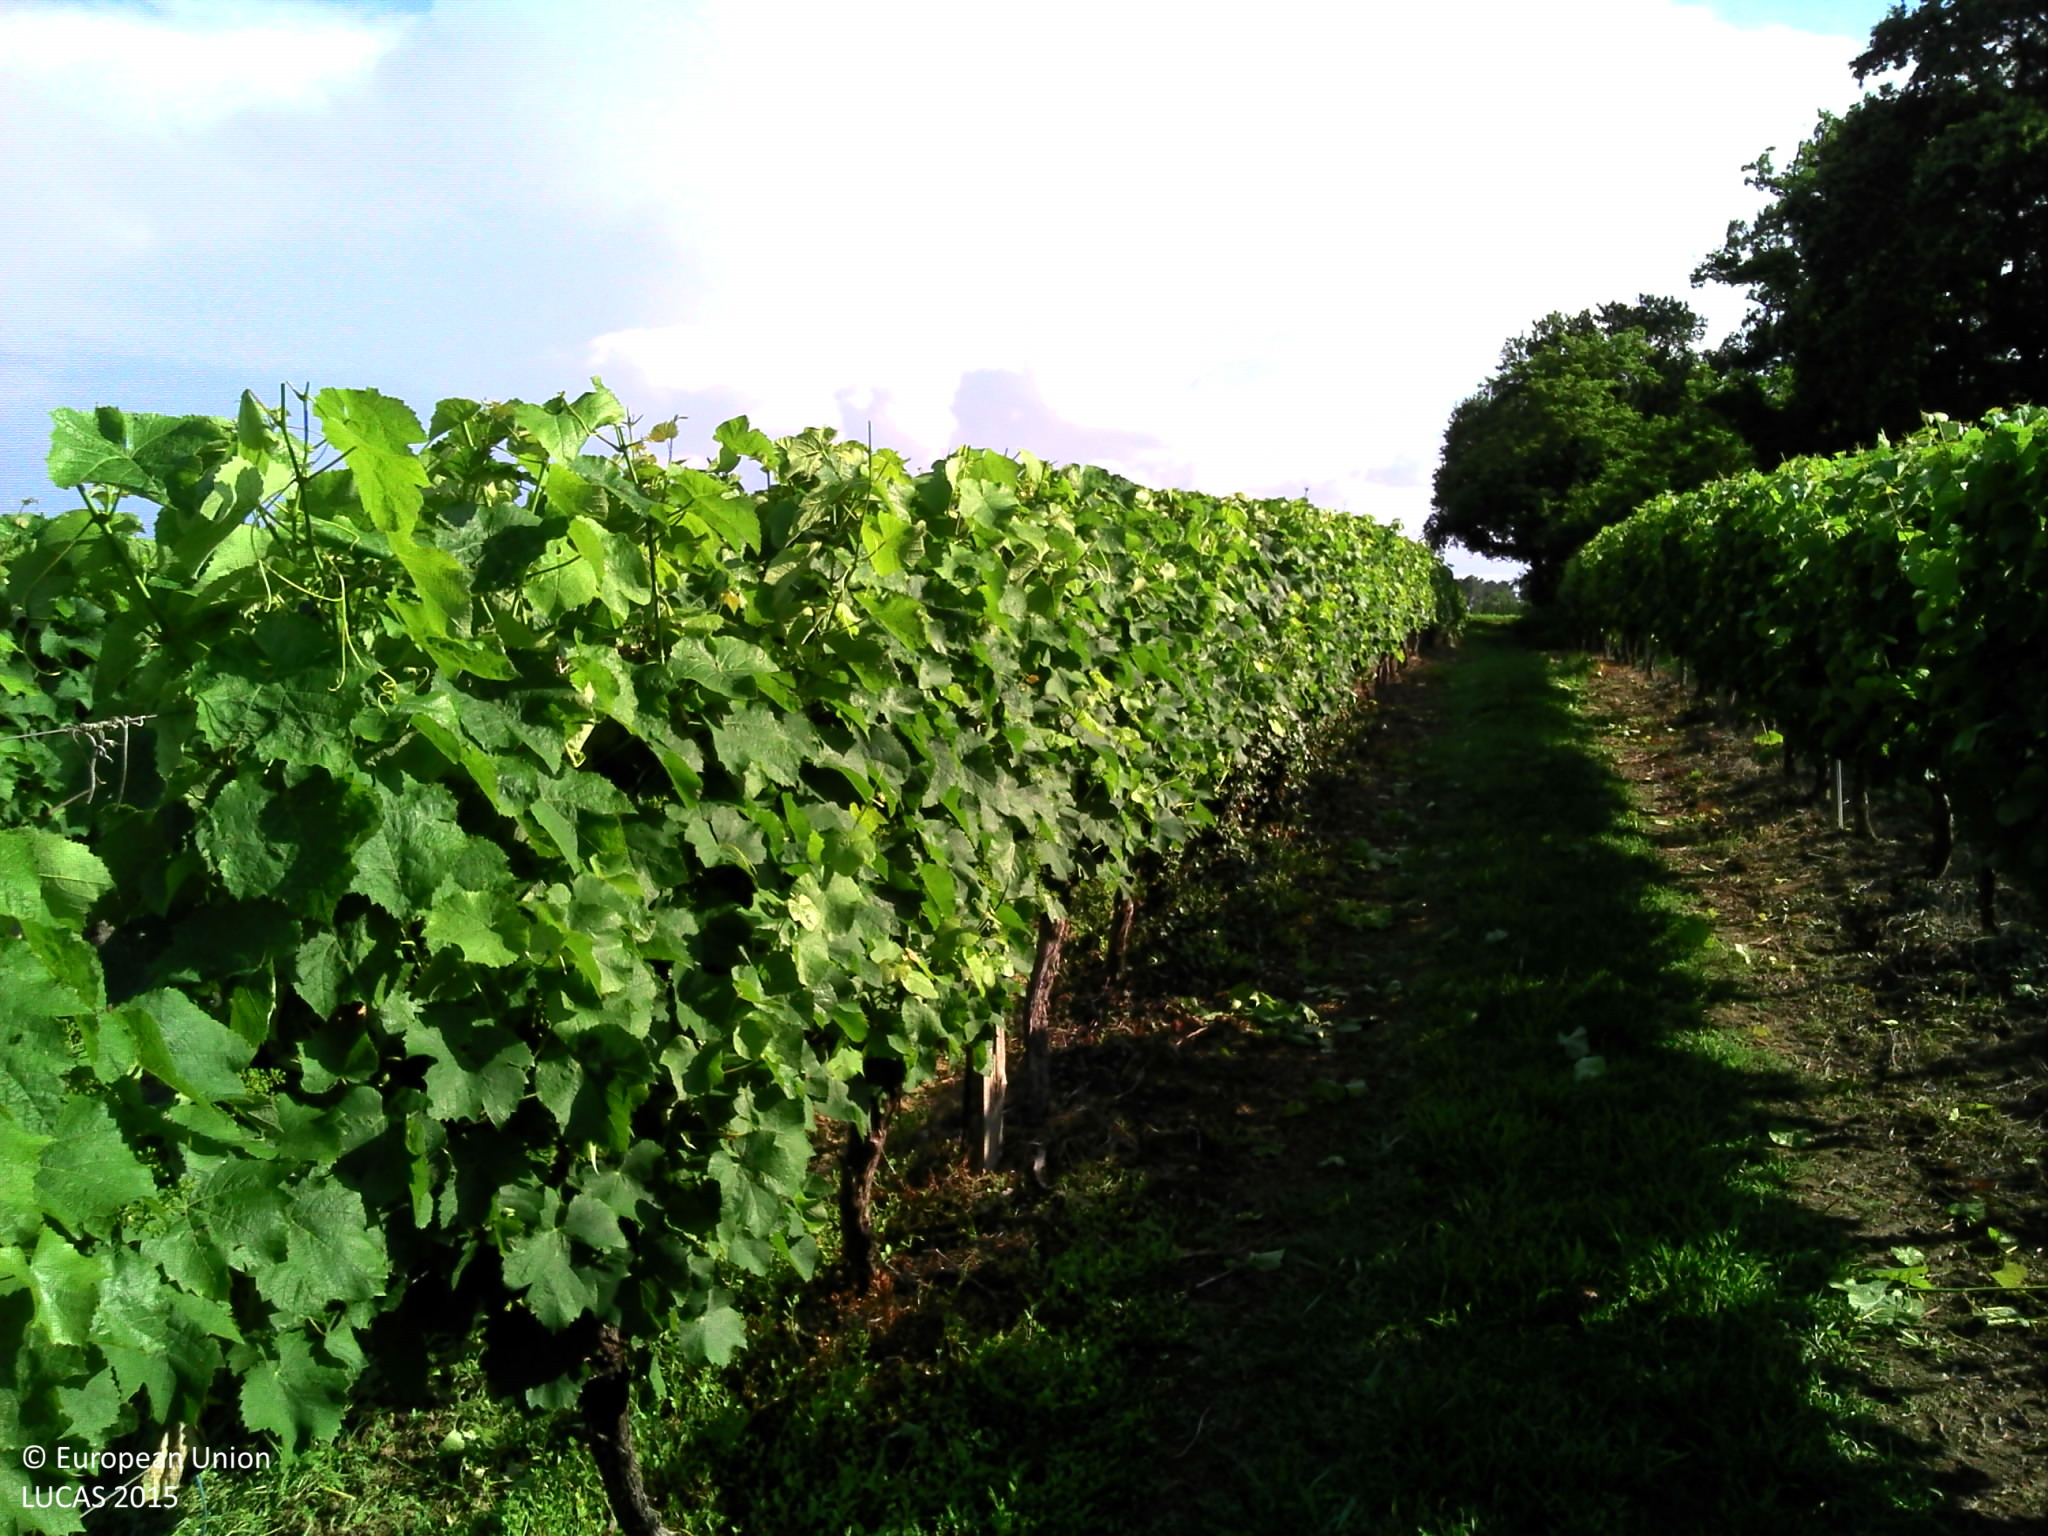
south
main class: Cropland
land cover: Vineyards
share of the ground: 25 - 50 %
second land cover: Grassland without tree/shrub cover
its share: 25 - 50 %
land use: Agriculture (excluding fallow land and kitchen gardens)
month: June
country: FR
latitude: 43.8421
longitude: -0.2459
